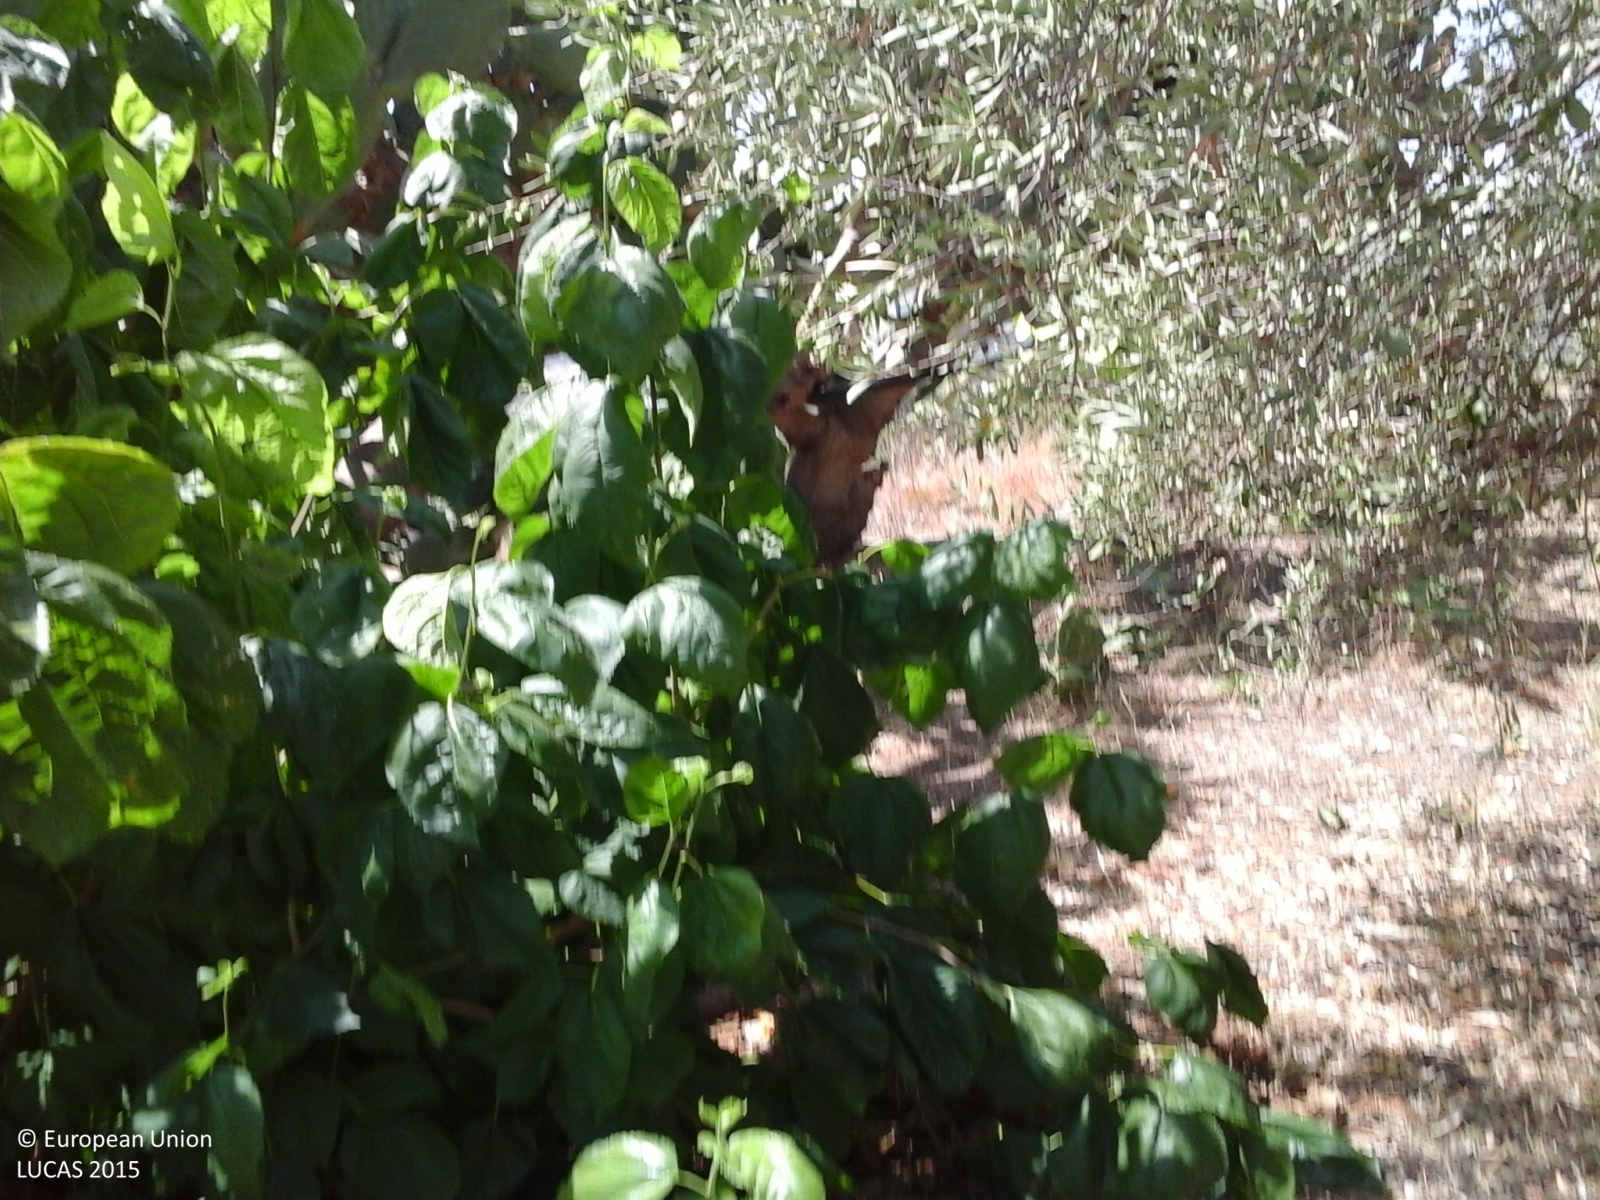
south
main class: Cropland
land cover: Olive groves
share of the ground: > 75 %
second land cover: Spontaneously vegetated surfaces
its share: > 75 %
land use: Agriculture (excluding fallow land and kitchen gardens)
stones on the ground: < 10 %
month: August
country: IT
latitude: 37.2976
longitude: 14.8261
